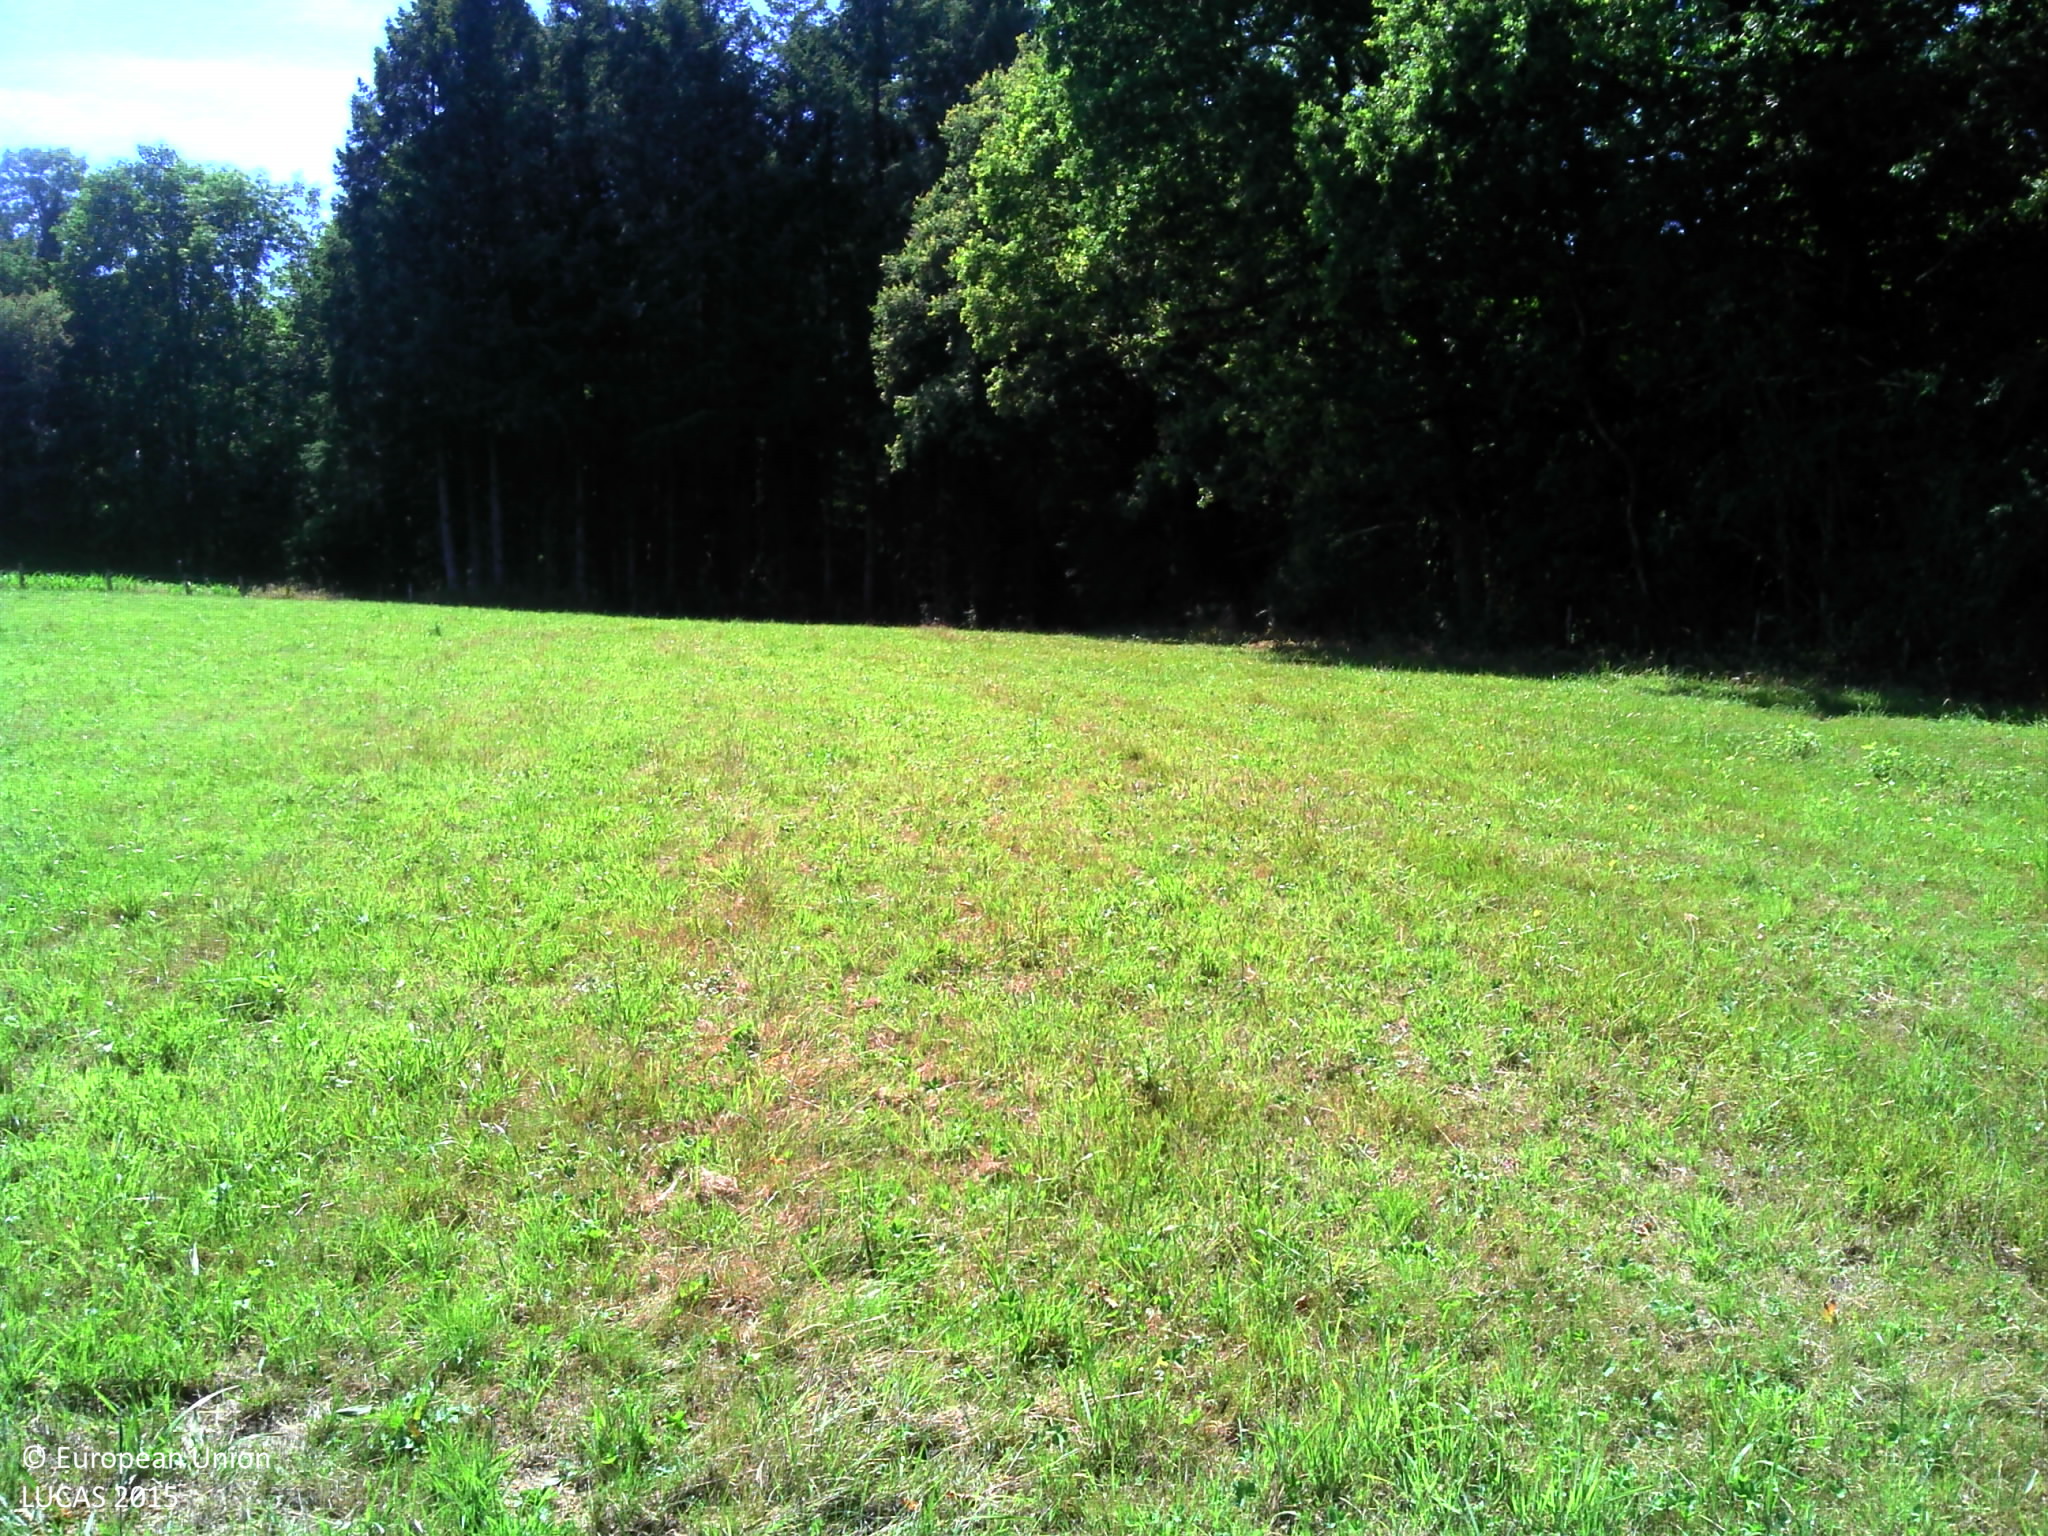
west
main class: Grassland
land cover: Grassland without tree/shrub cover
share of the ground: > 75 %
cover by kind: herbaceous plants 100 %
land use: Agriculture (excluding fallow land and kitchen gardens)
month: June
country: FR
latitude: 47.5091
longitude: 6.1908
